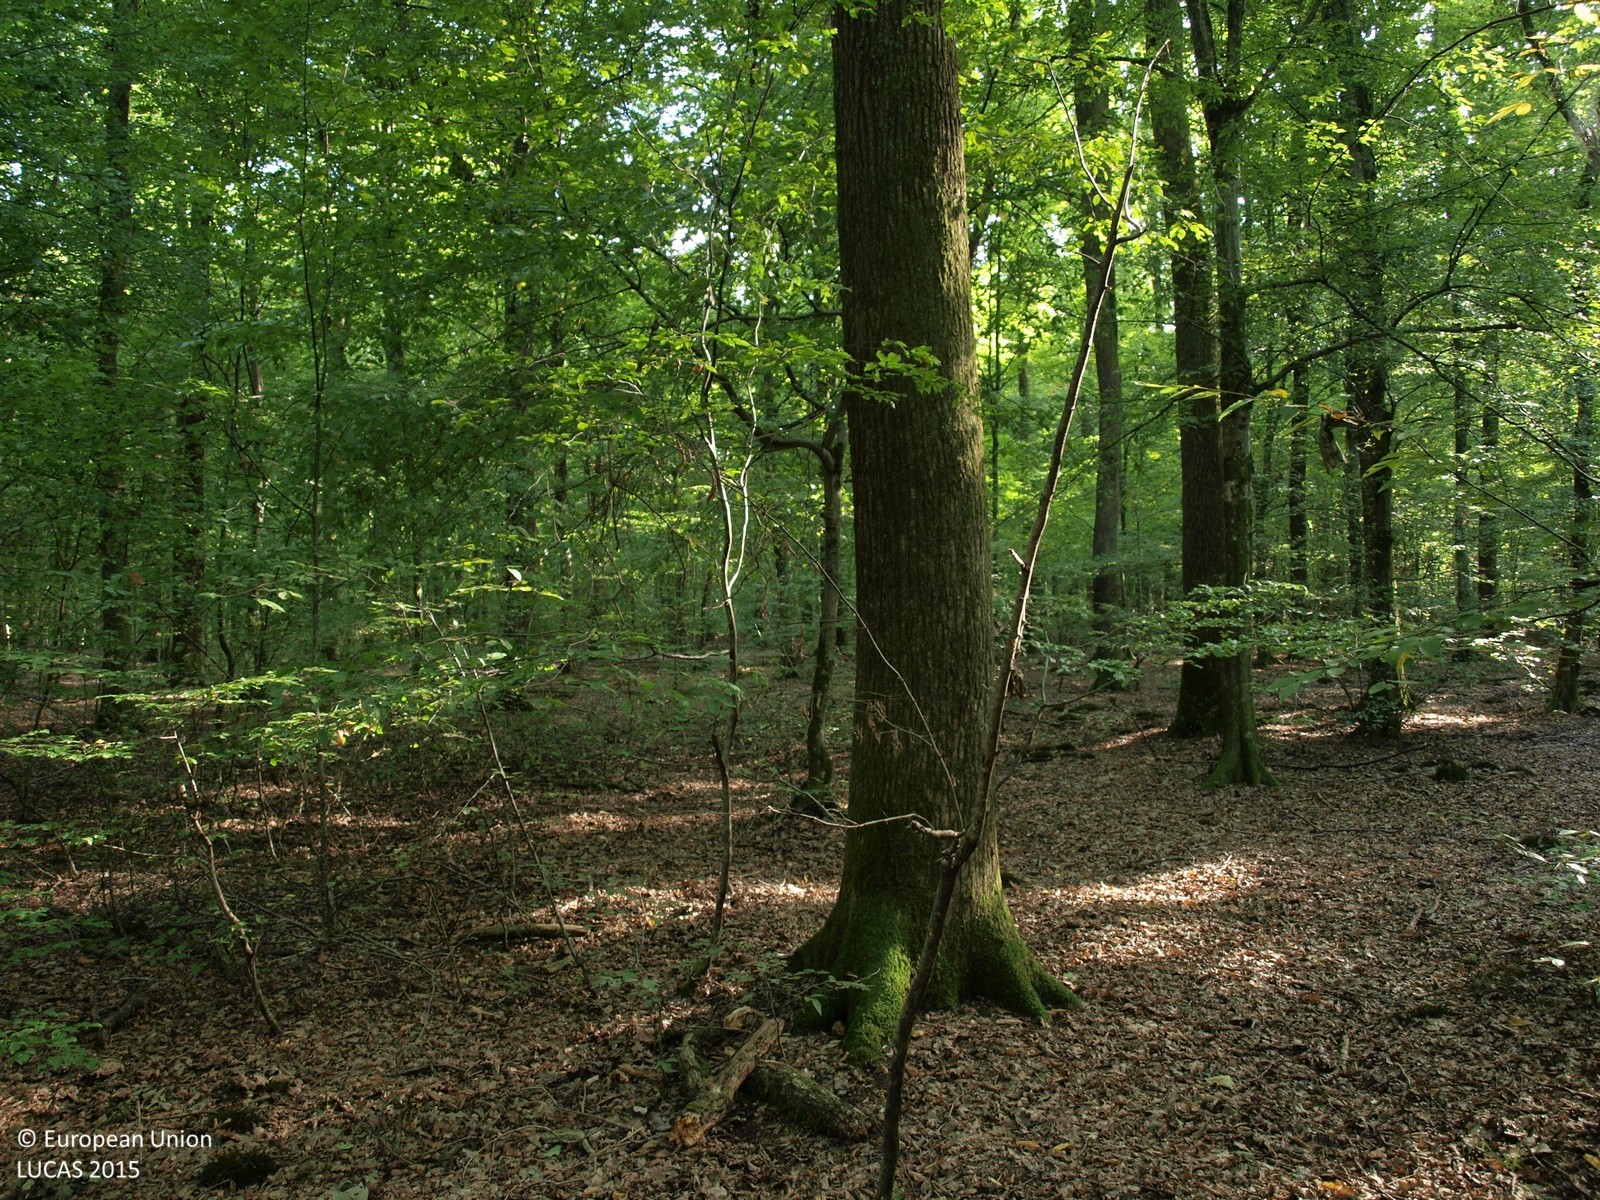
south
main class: Woodland
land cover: Broadleaved woodland
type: mesophytic deciduous forest
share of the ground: > 75 %
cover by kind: broadleaved forest trees 100 %
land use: Forestry
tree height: > 5 m
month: September
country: HR
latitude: 45.6177
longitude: 16.0892
